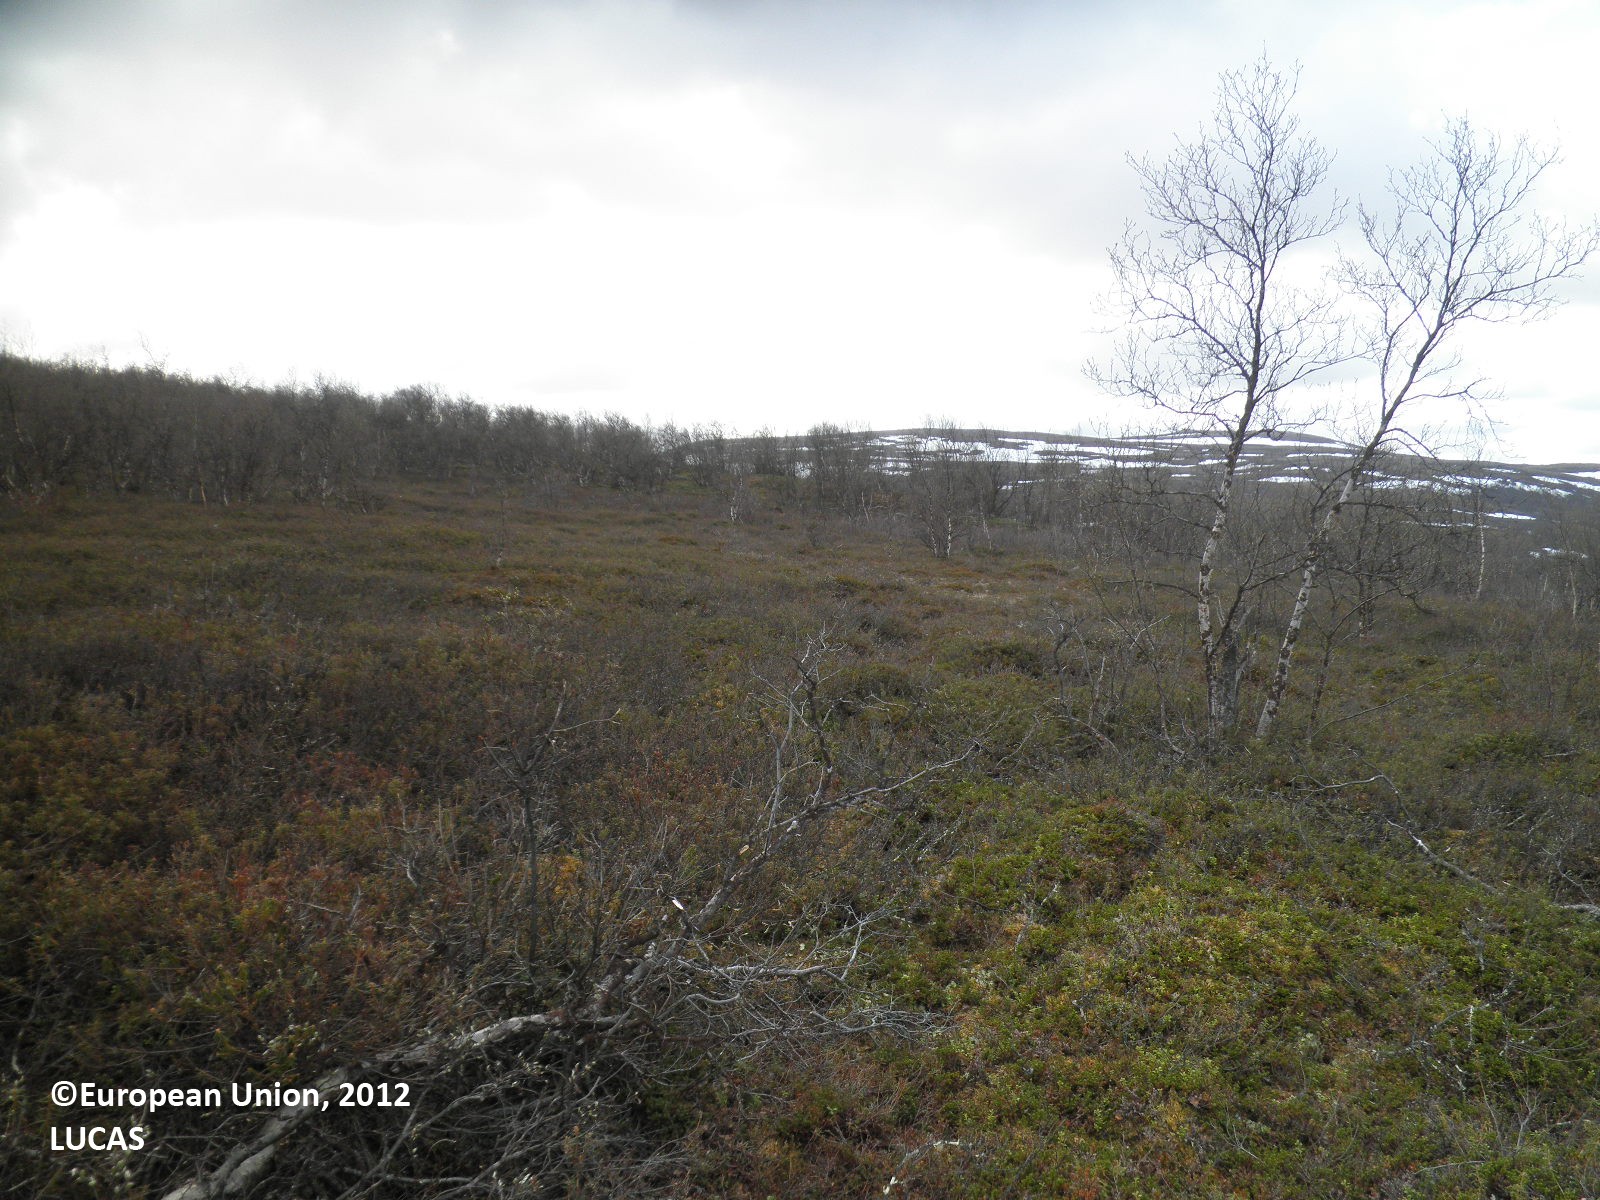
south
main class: Woodland
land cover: Broadleaved woodland
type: boreal forest
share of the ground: 10 - 25 %
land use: Forestry
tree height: < 5 m
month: May
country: FI
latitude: 70.0248
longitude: 27.5466
